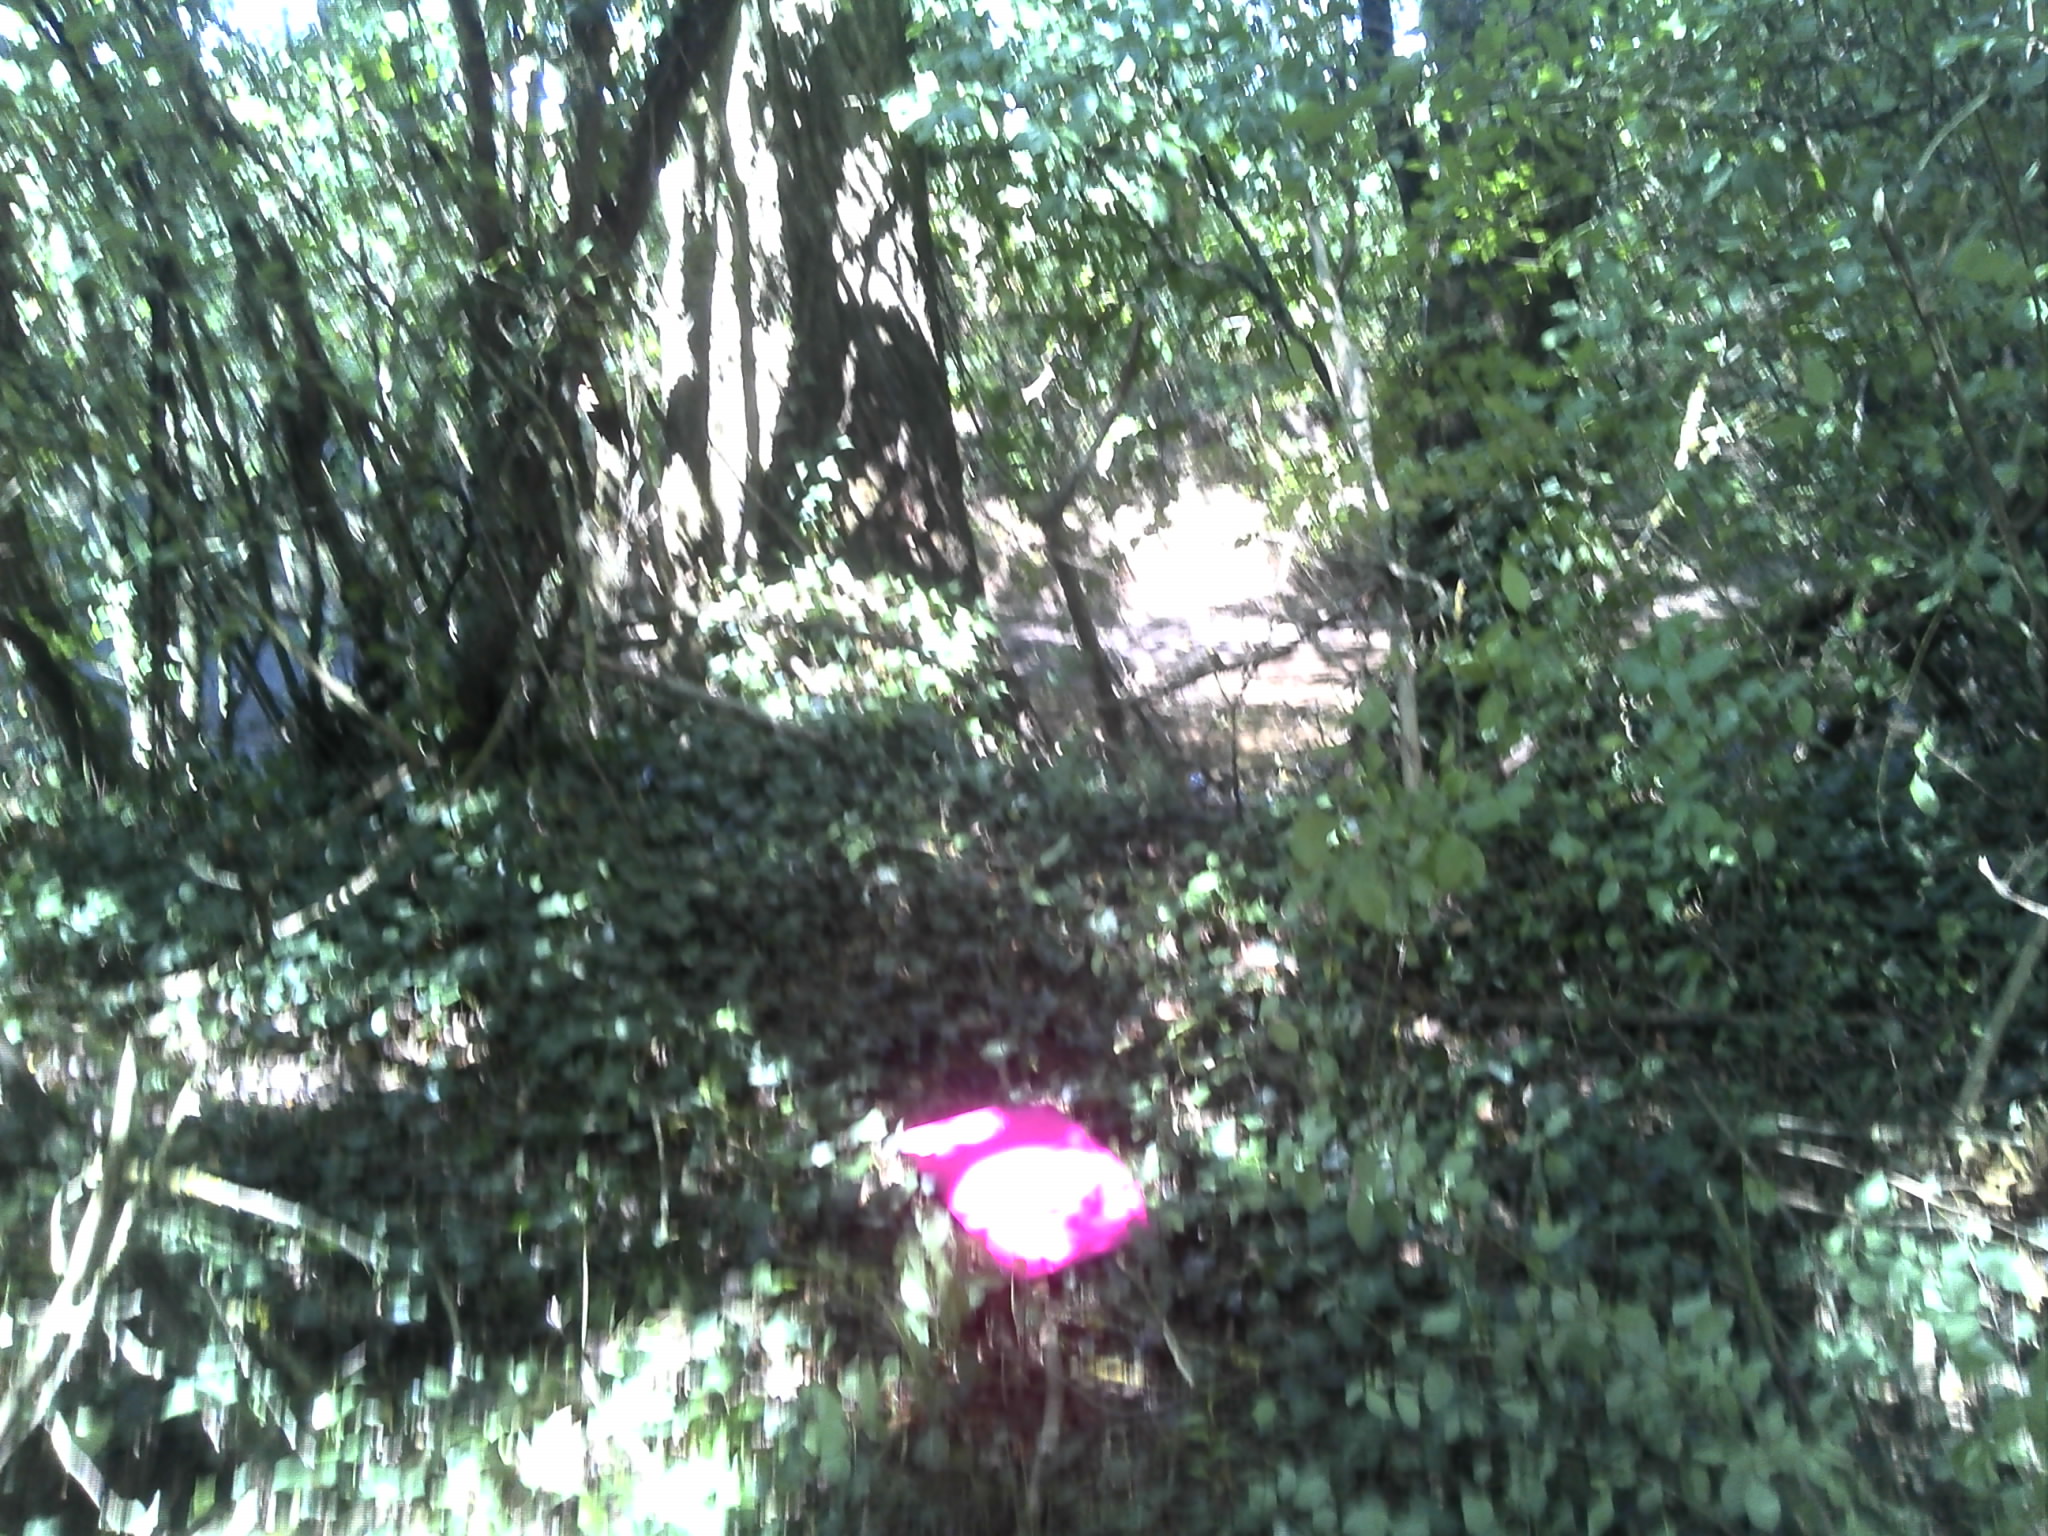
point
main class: Woodland
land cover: Broadleaved woodland
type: mesophytic deciduous forest
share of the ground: > 75 %
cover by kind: broadleaved forest trees 90 %, shrubs 10 %
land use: Agriculture (excluding fallow land and kitchen gardens)
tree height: > 5 m
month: August
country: FR
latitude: 46.8317
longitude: 1.5590
